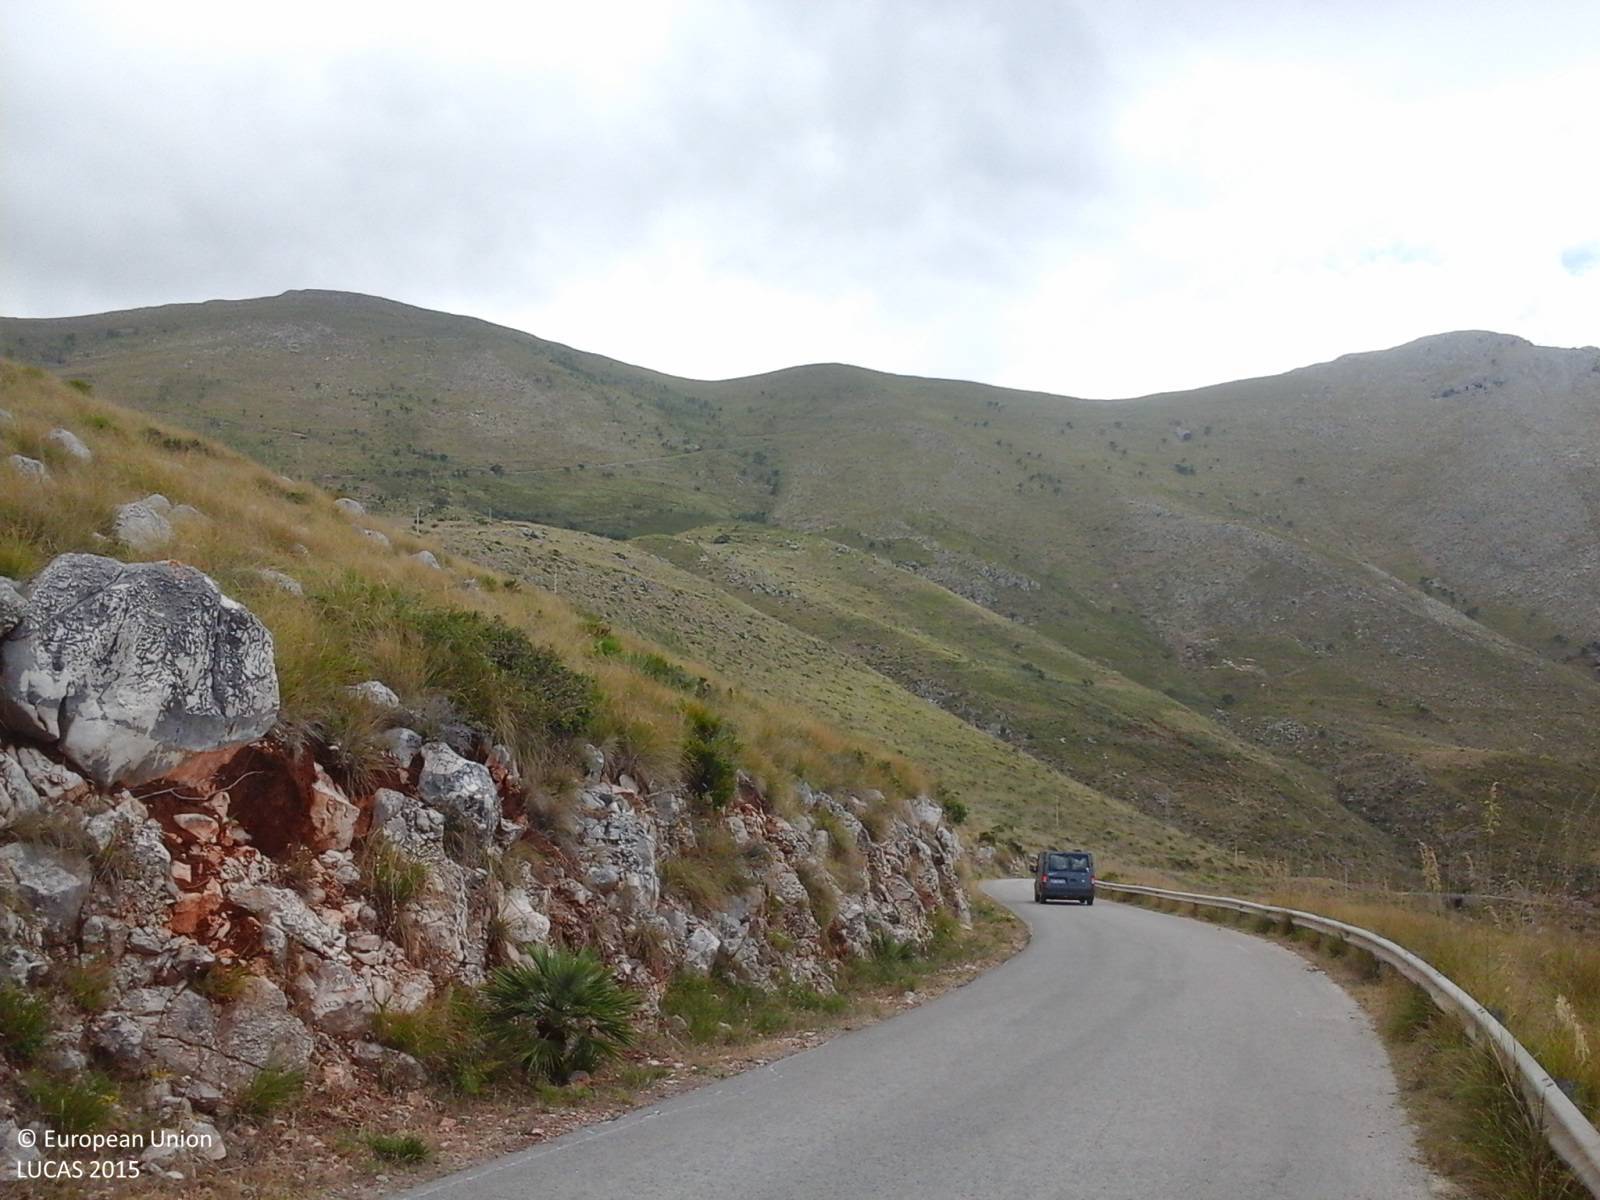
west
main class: Grassland
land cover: Grassland without tree/shrub cover
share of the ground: > 75 %
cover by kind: herbaceous plants 100 %
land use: Semi-natural and natural areas not in use
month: June
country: IT
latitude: 38.1429
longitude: 12.7759
